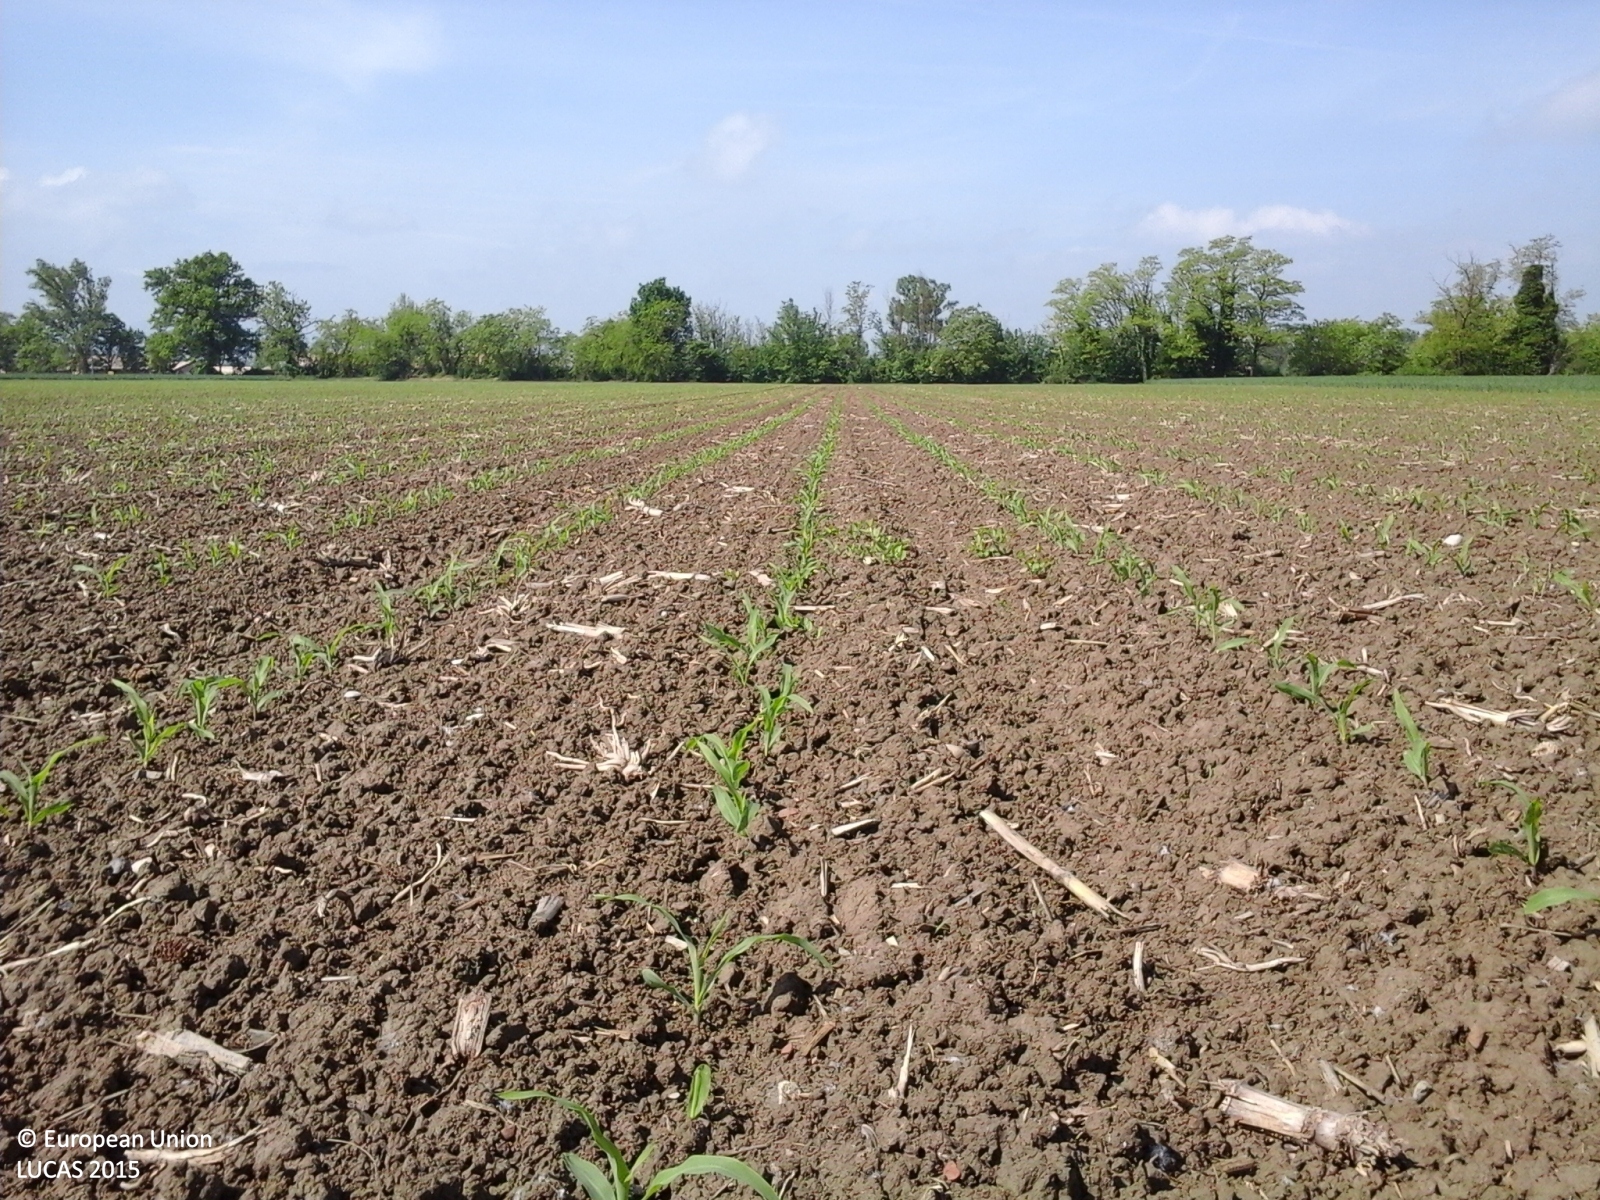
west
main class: Cropland
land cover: Maize
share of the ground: < 10 %
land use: Agriculture (excluding fallow land and kitchen gardens)
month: May
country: IT
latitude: 44.9990
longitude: 9.6075
